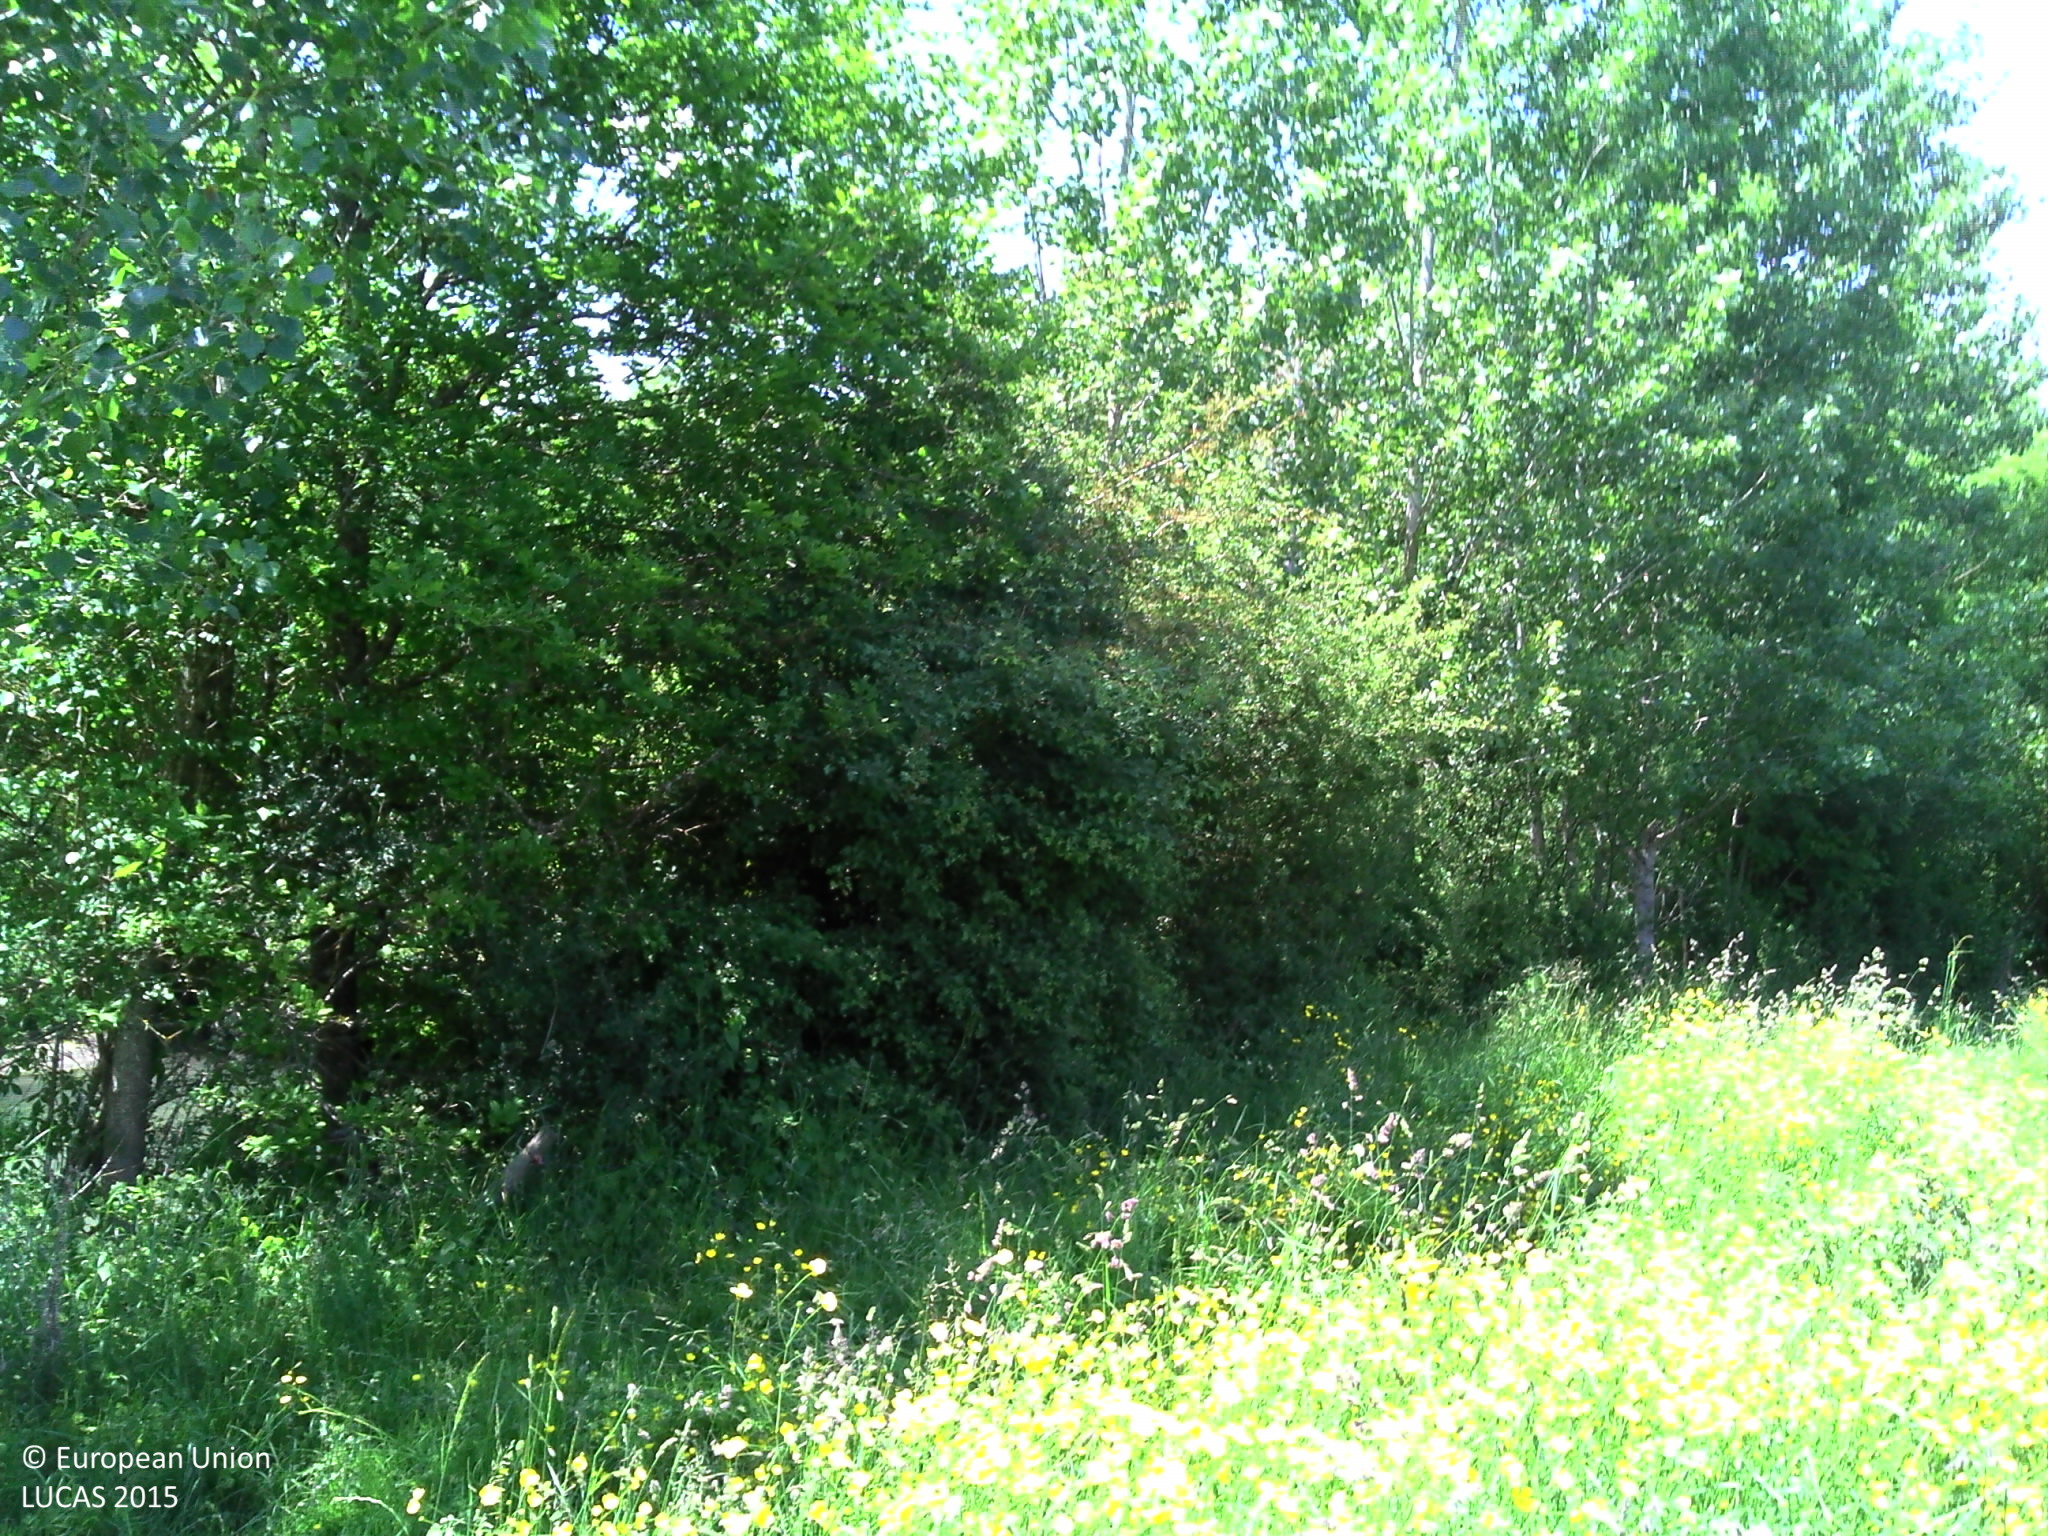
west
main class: Grassland
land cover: Grassland without tree/shrub cover
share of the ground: > 75 %
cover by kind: herbaceous plants 100 %
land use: Agriculture (excluding fallow land and kitchen gardens)
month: May
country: FR
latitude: 47.2716
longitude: 2.8963
